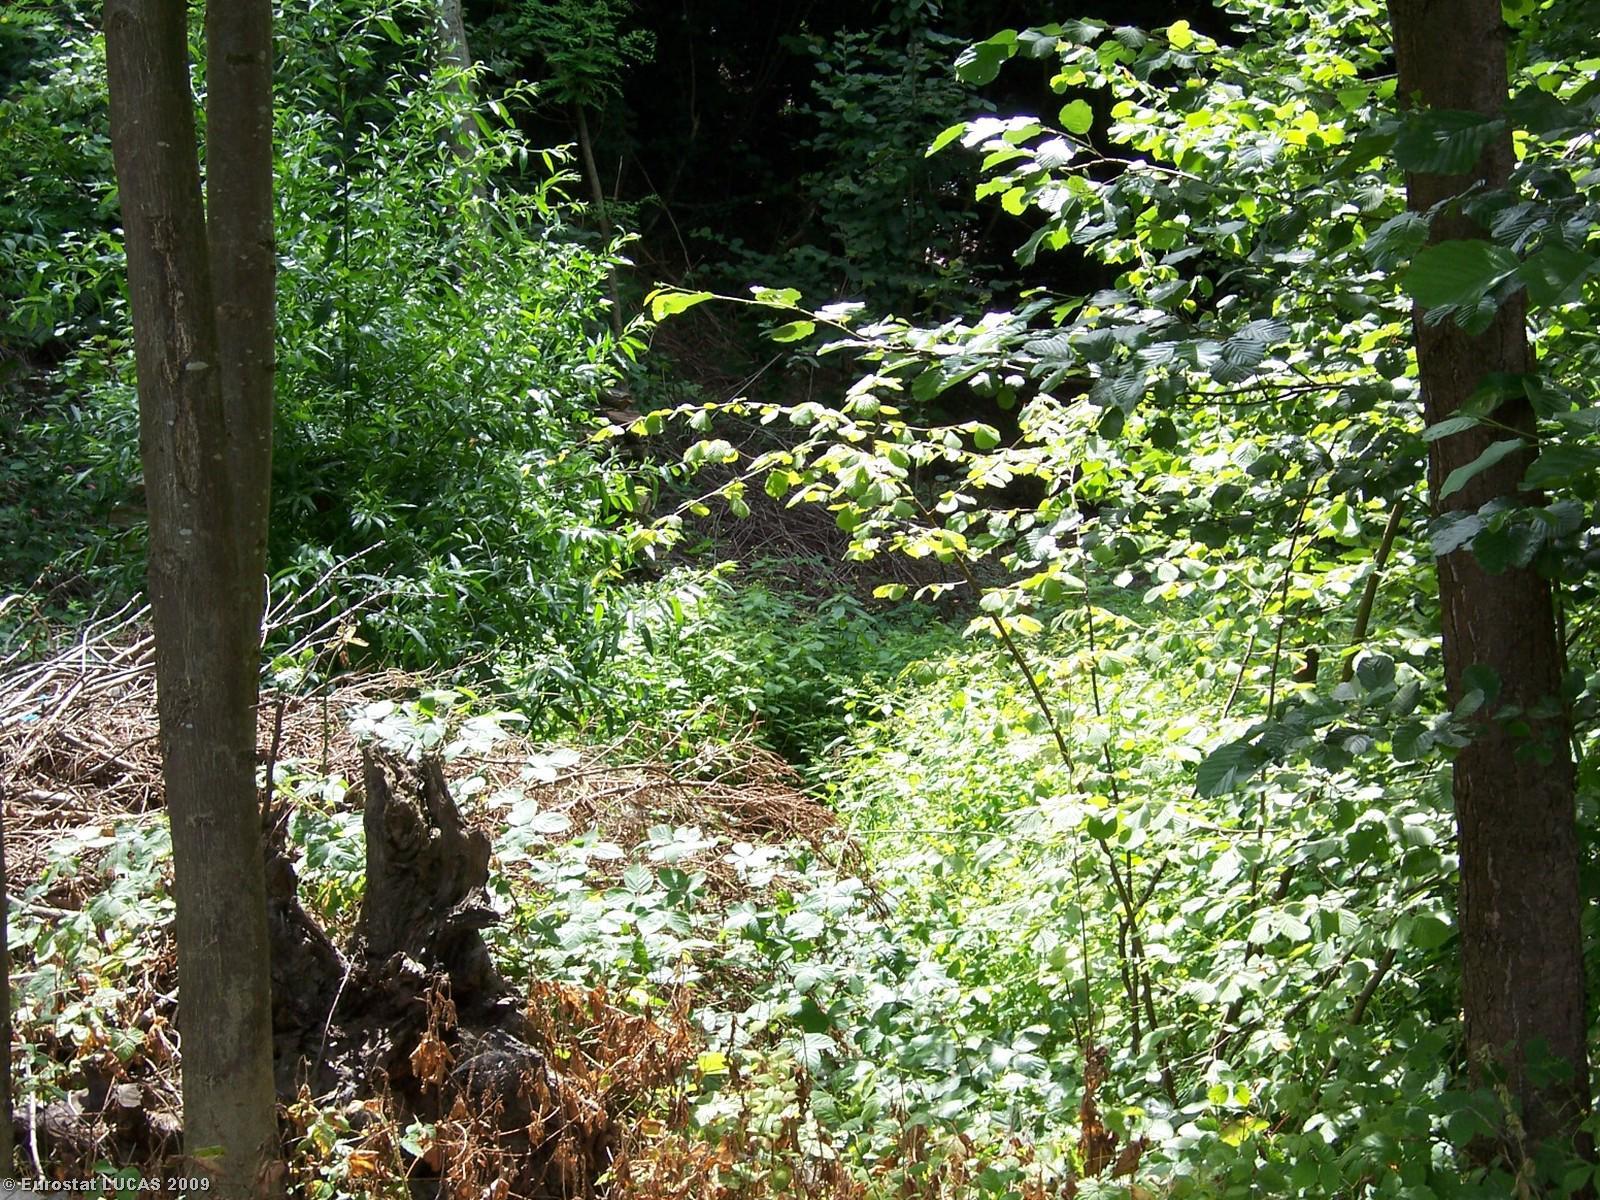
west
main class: Woodland
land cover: Broadleaved woodland
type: mesophytic deciduous forest
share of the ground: > 75 %
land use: Unused
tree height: > 5 m
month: June
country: IT
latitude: 44.9117
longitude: 7.3321
